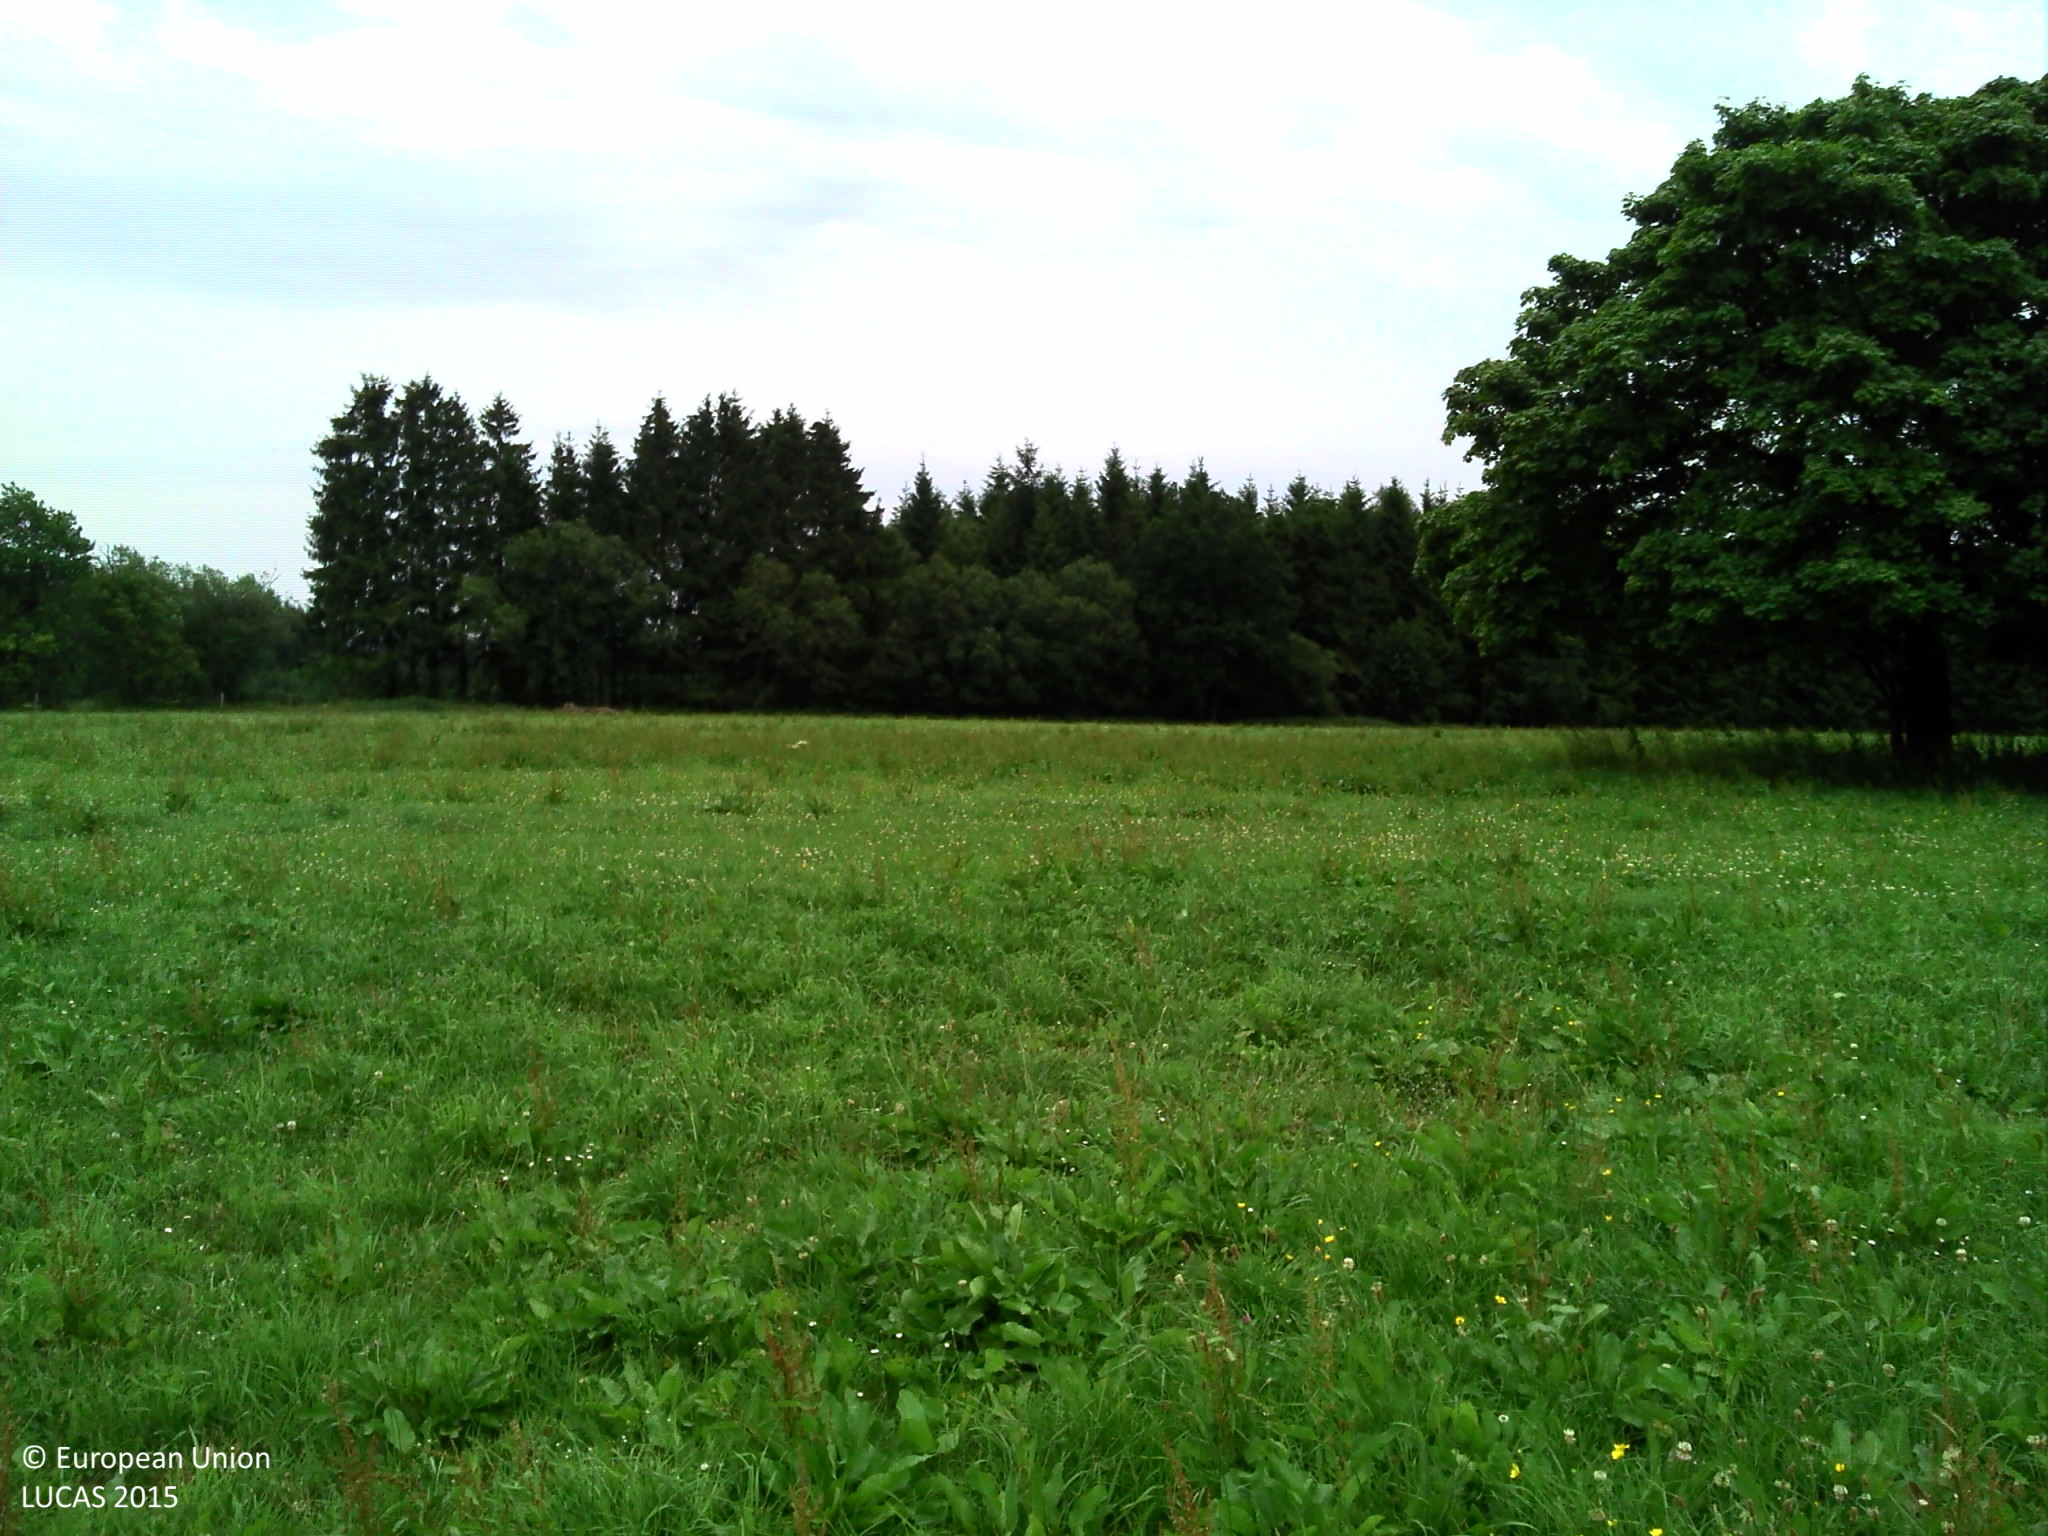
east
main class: Grassland
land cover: Grassland without tree/shrub cover
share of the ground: > 75 %
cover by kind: herbaceous plants 100 %
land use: Agriculture (excluding fallow land and kitchen gardens)
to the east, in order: Grassland without tree/shrub cover; Fences; Spruce dominated coniferous woodland; Tracks; Fences; Spontaneously vegetated surfaces
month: July
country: BE
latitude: 50.2532
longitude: 5.8614
